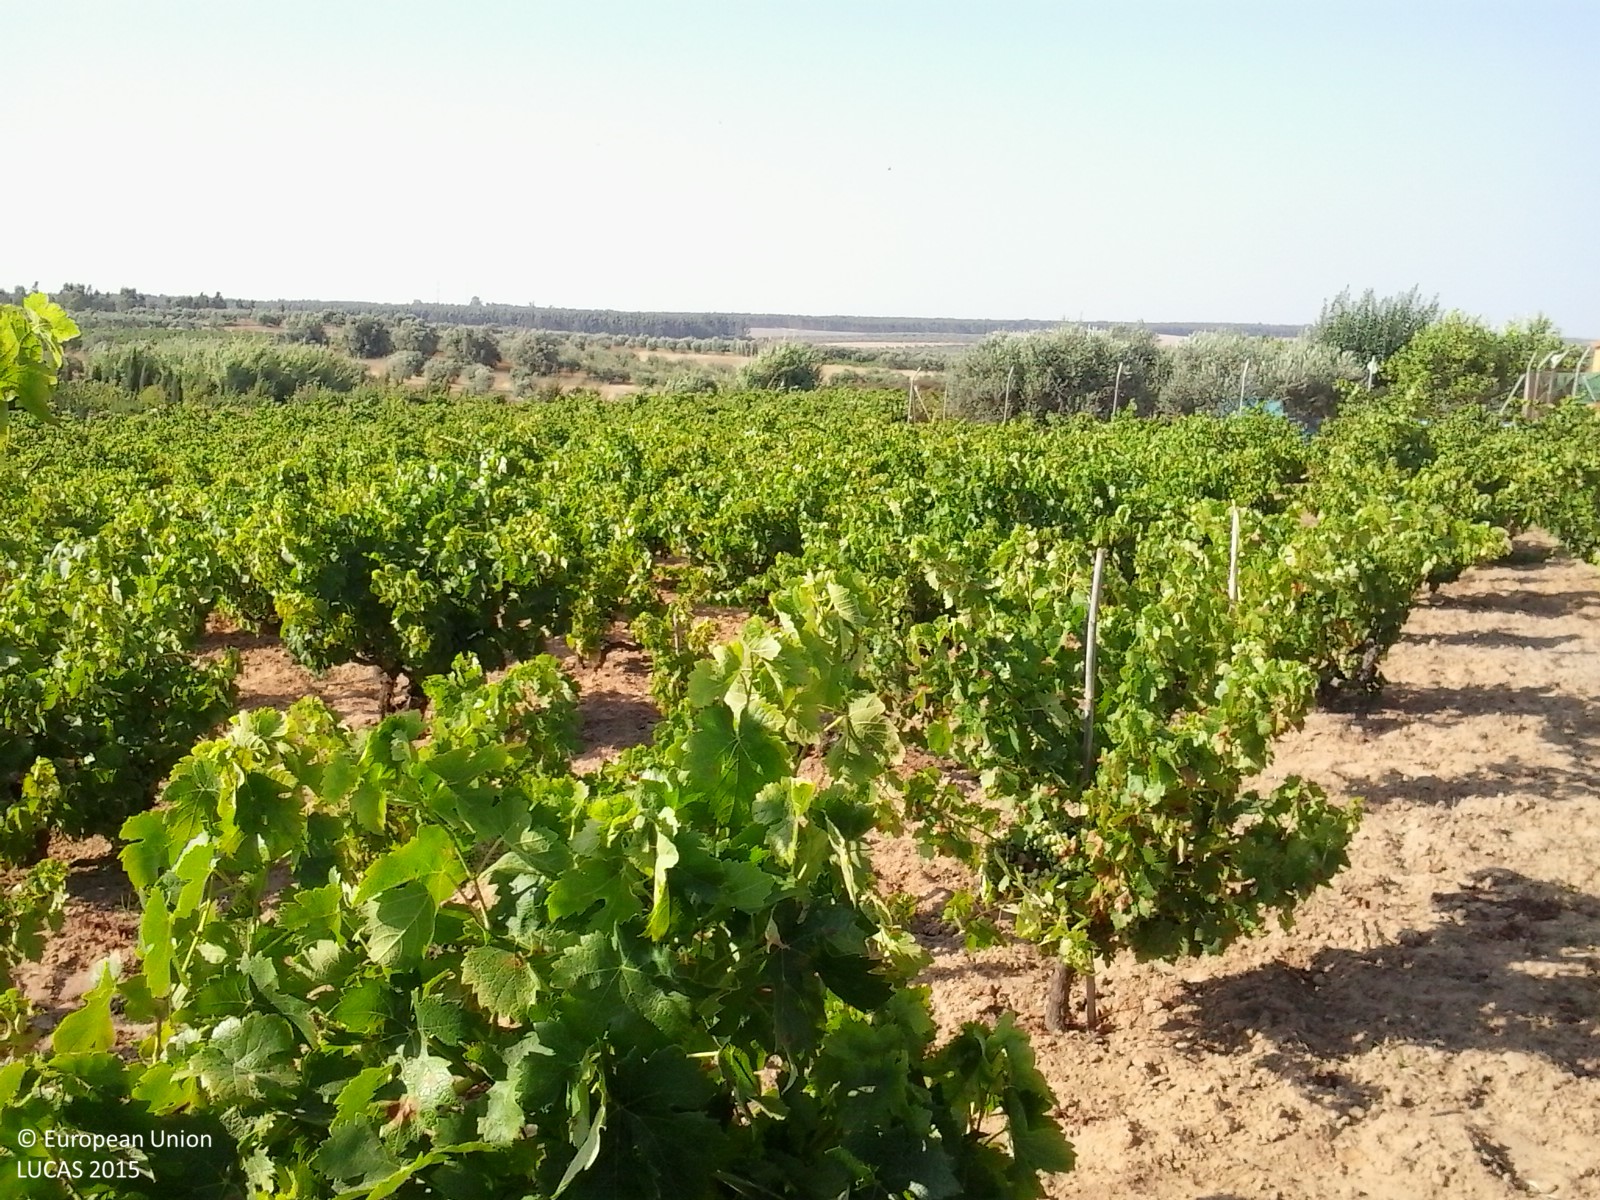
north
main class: Cropland
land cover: Vineyards
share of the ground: 10 - 25 %
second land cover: Other bare soil
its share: > 75 %
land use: Agriculture (excluding fallow land and kitchen gardens)
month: June
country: ES
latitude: 37.3727
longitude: -6.4619
